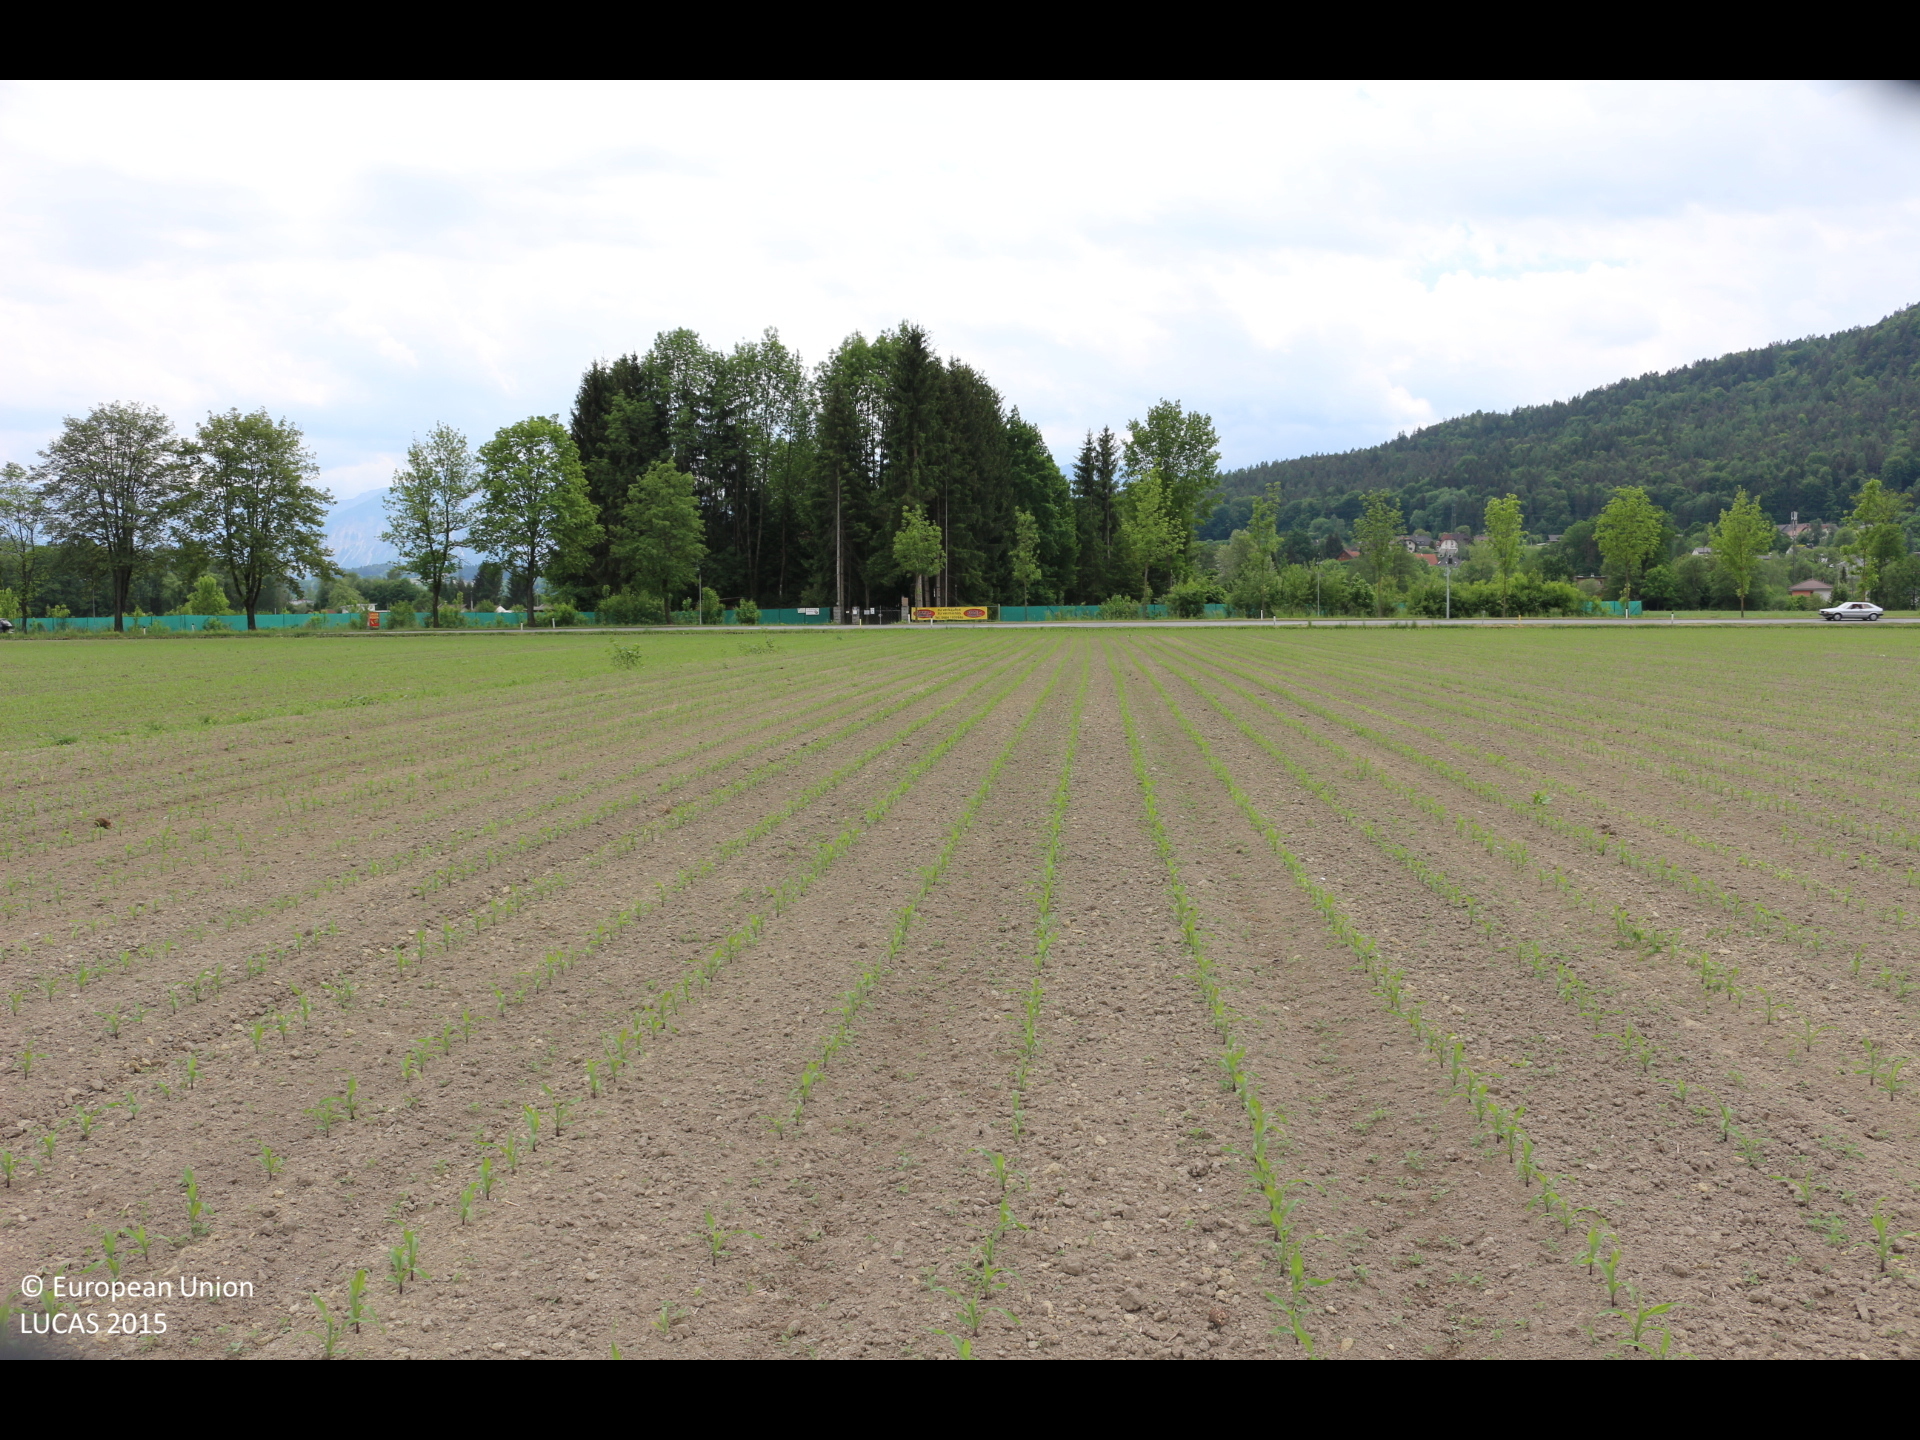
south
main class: Cropland
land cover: Maize
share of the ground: 10 - 25 %
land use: Agriculture (excluding fallow land and kitchen gardens)
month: May
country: AT
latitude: 46.6088
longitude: 14.2668
